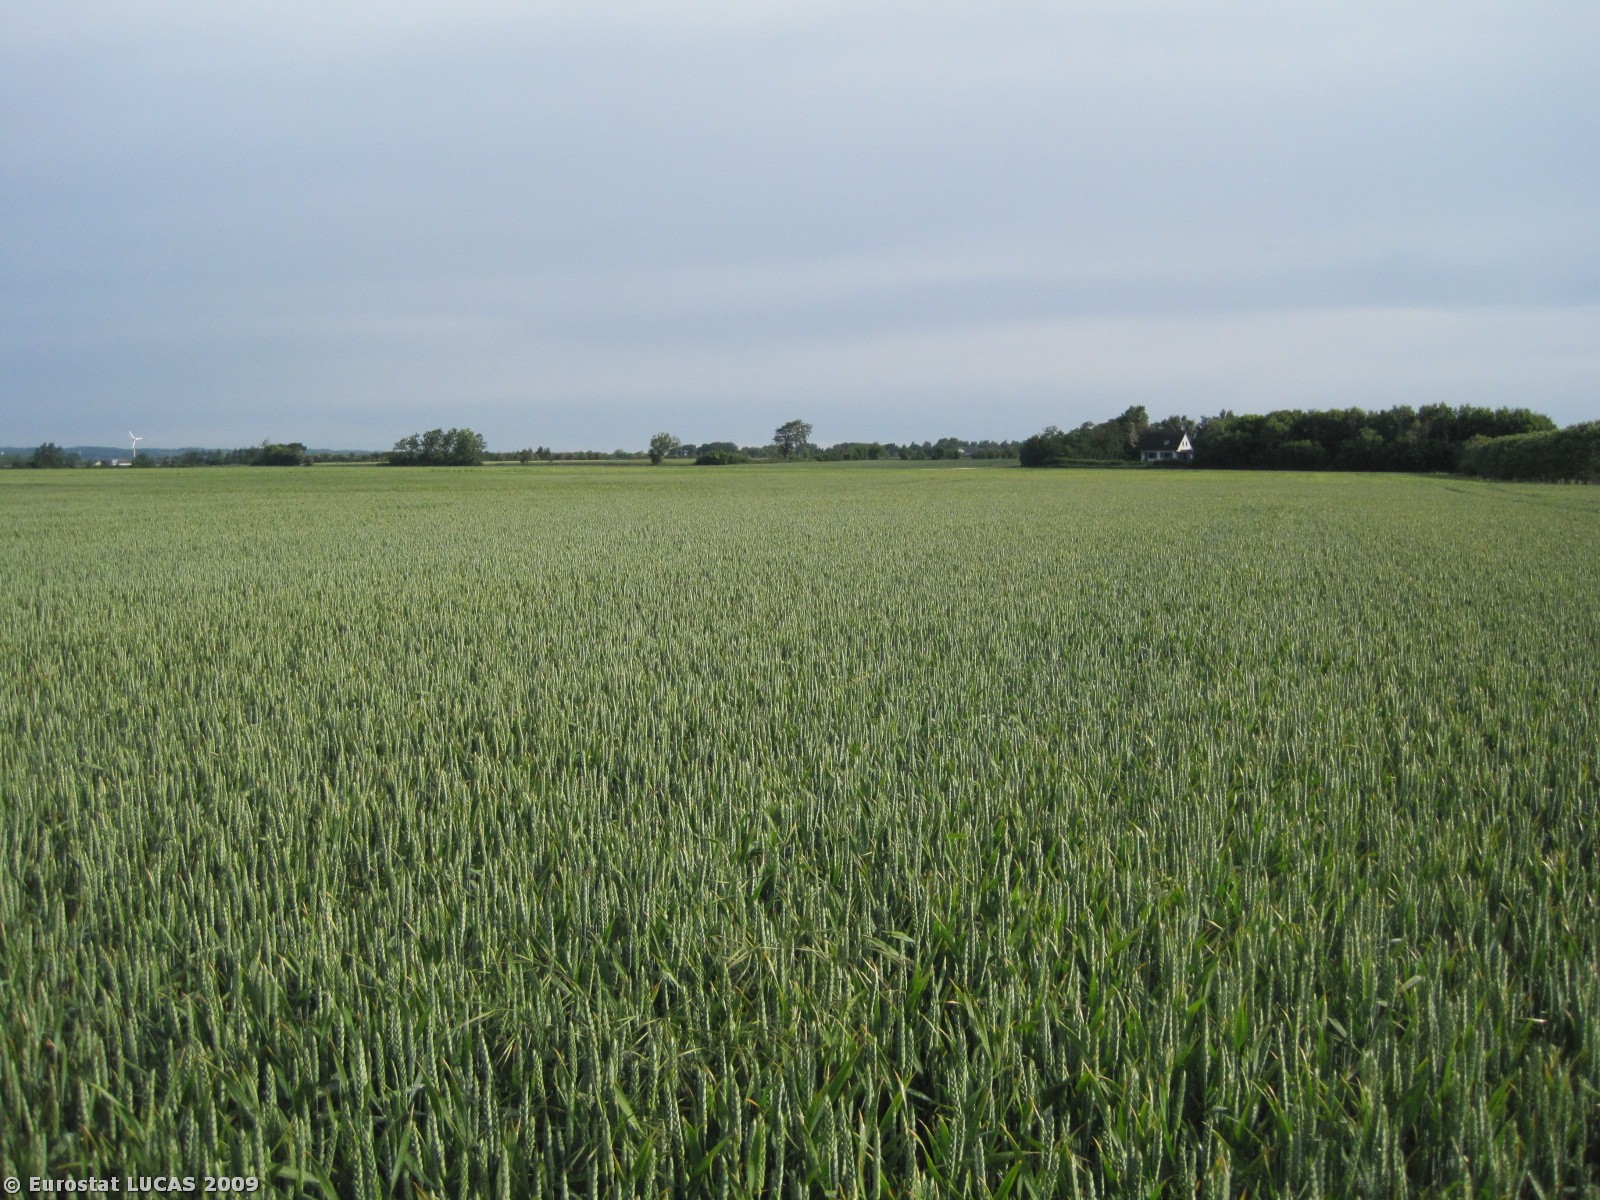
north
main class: Cropland
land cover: Common wheat
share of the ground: > 75 %
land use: Agriculture (excluding fallow land and kitchen gardens)
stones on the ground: < 10 %
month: June
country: DK
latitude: 57.0686
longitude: 10.0823
